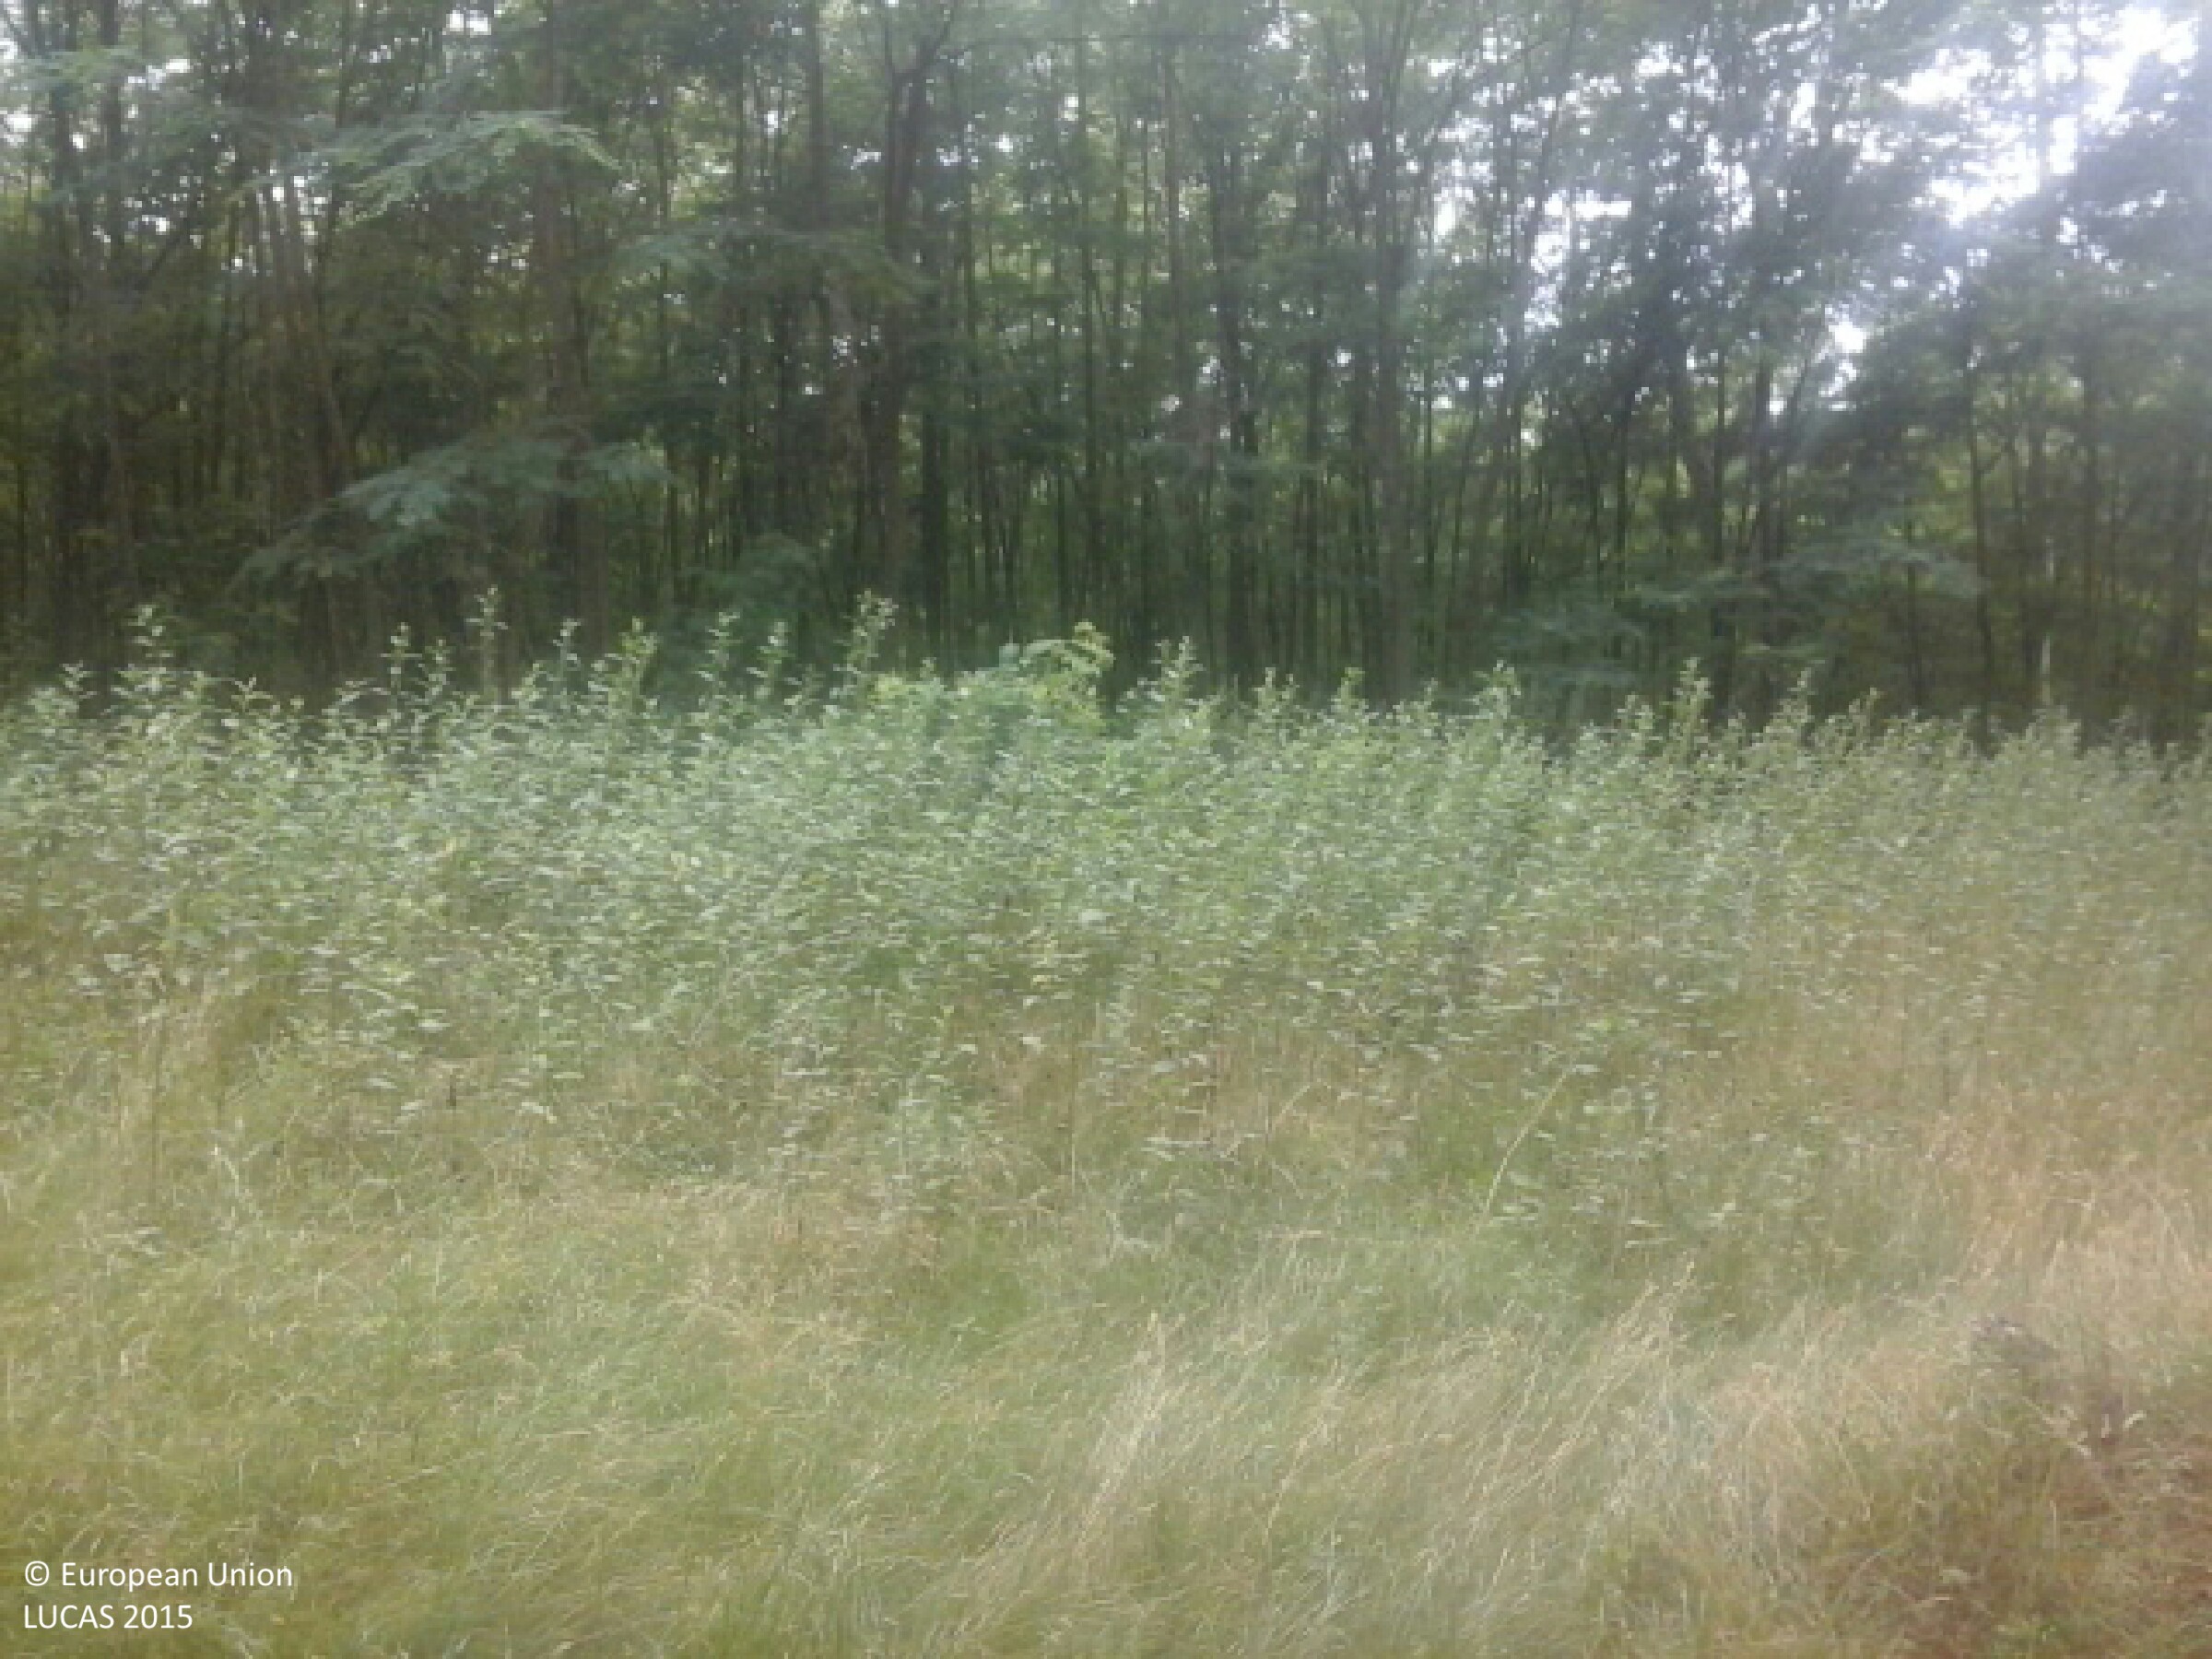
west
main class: Woodland
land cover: Broadleaved woodland
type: mesophytic deciduous forest
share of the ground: > 75 %
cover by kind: broadleaved forest trees 95 %, herbaceous plants 5 %
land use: Forestry
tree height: > 5 m
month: June
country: HU
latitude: 47.9465
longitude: 22.1712
